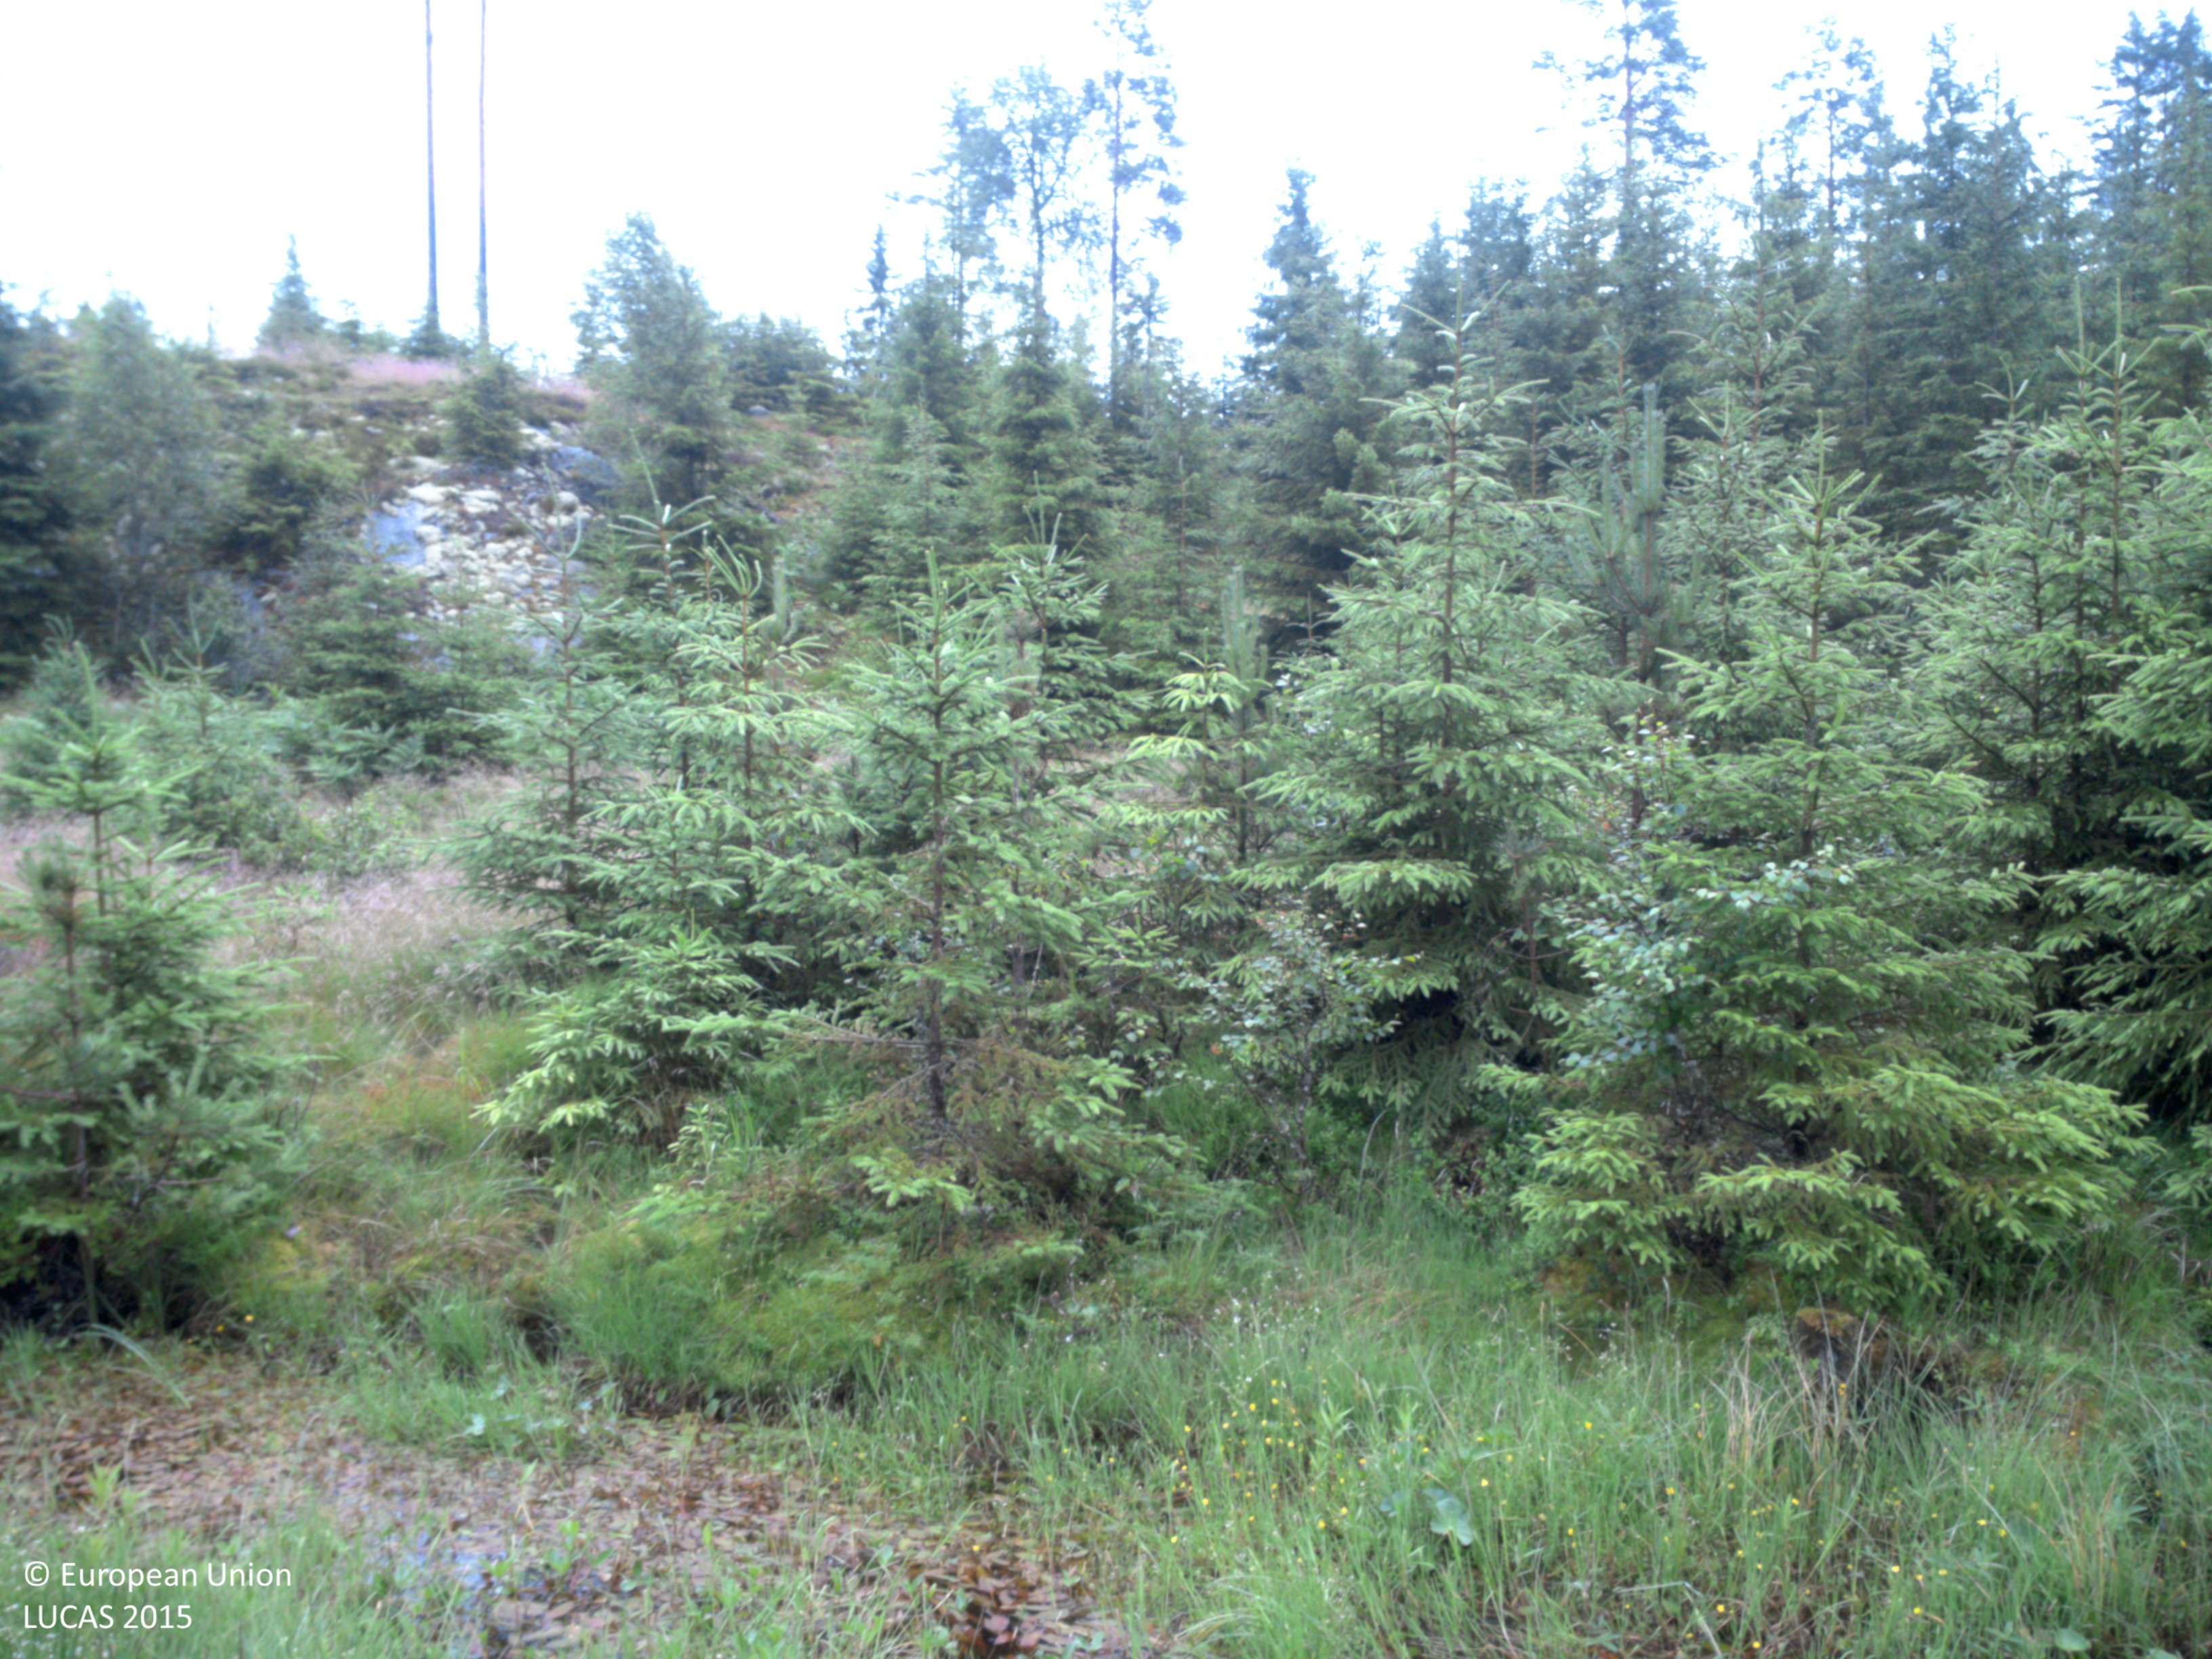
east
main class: Grassland
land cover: Grassland with sparse tree/shrub cover
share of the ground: > 75 %
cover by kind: herbaceous plants 95 %, coniferous forest trees 5 %
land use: Semi-natural and natural areas not in use
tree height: < 5 m
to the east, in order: Grassland with sparse tree/shrub cover; Ditches and canals; Spruce dominated coniferous woodland; Spruce dominated mixed woodland; Tracks; Spruce dominated mixed woodland
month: July
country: SE
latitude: 58.9060
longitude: 12.0265
